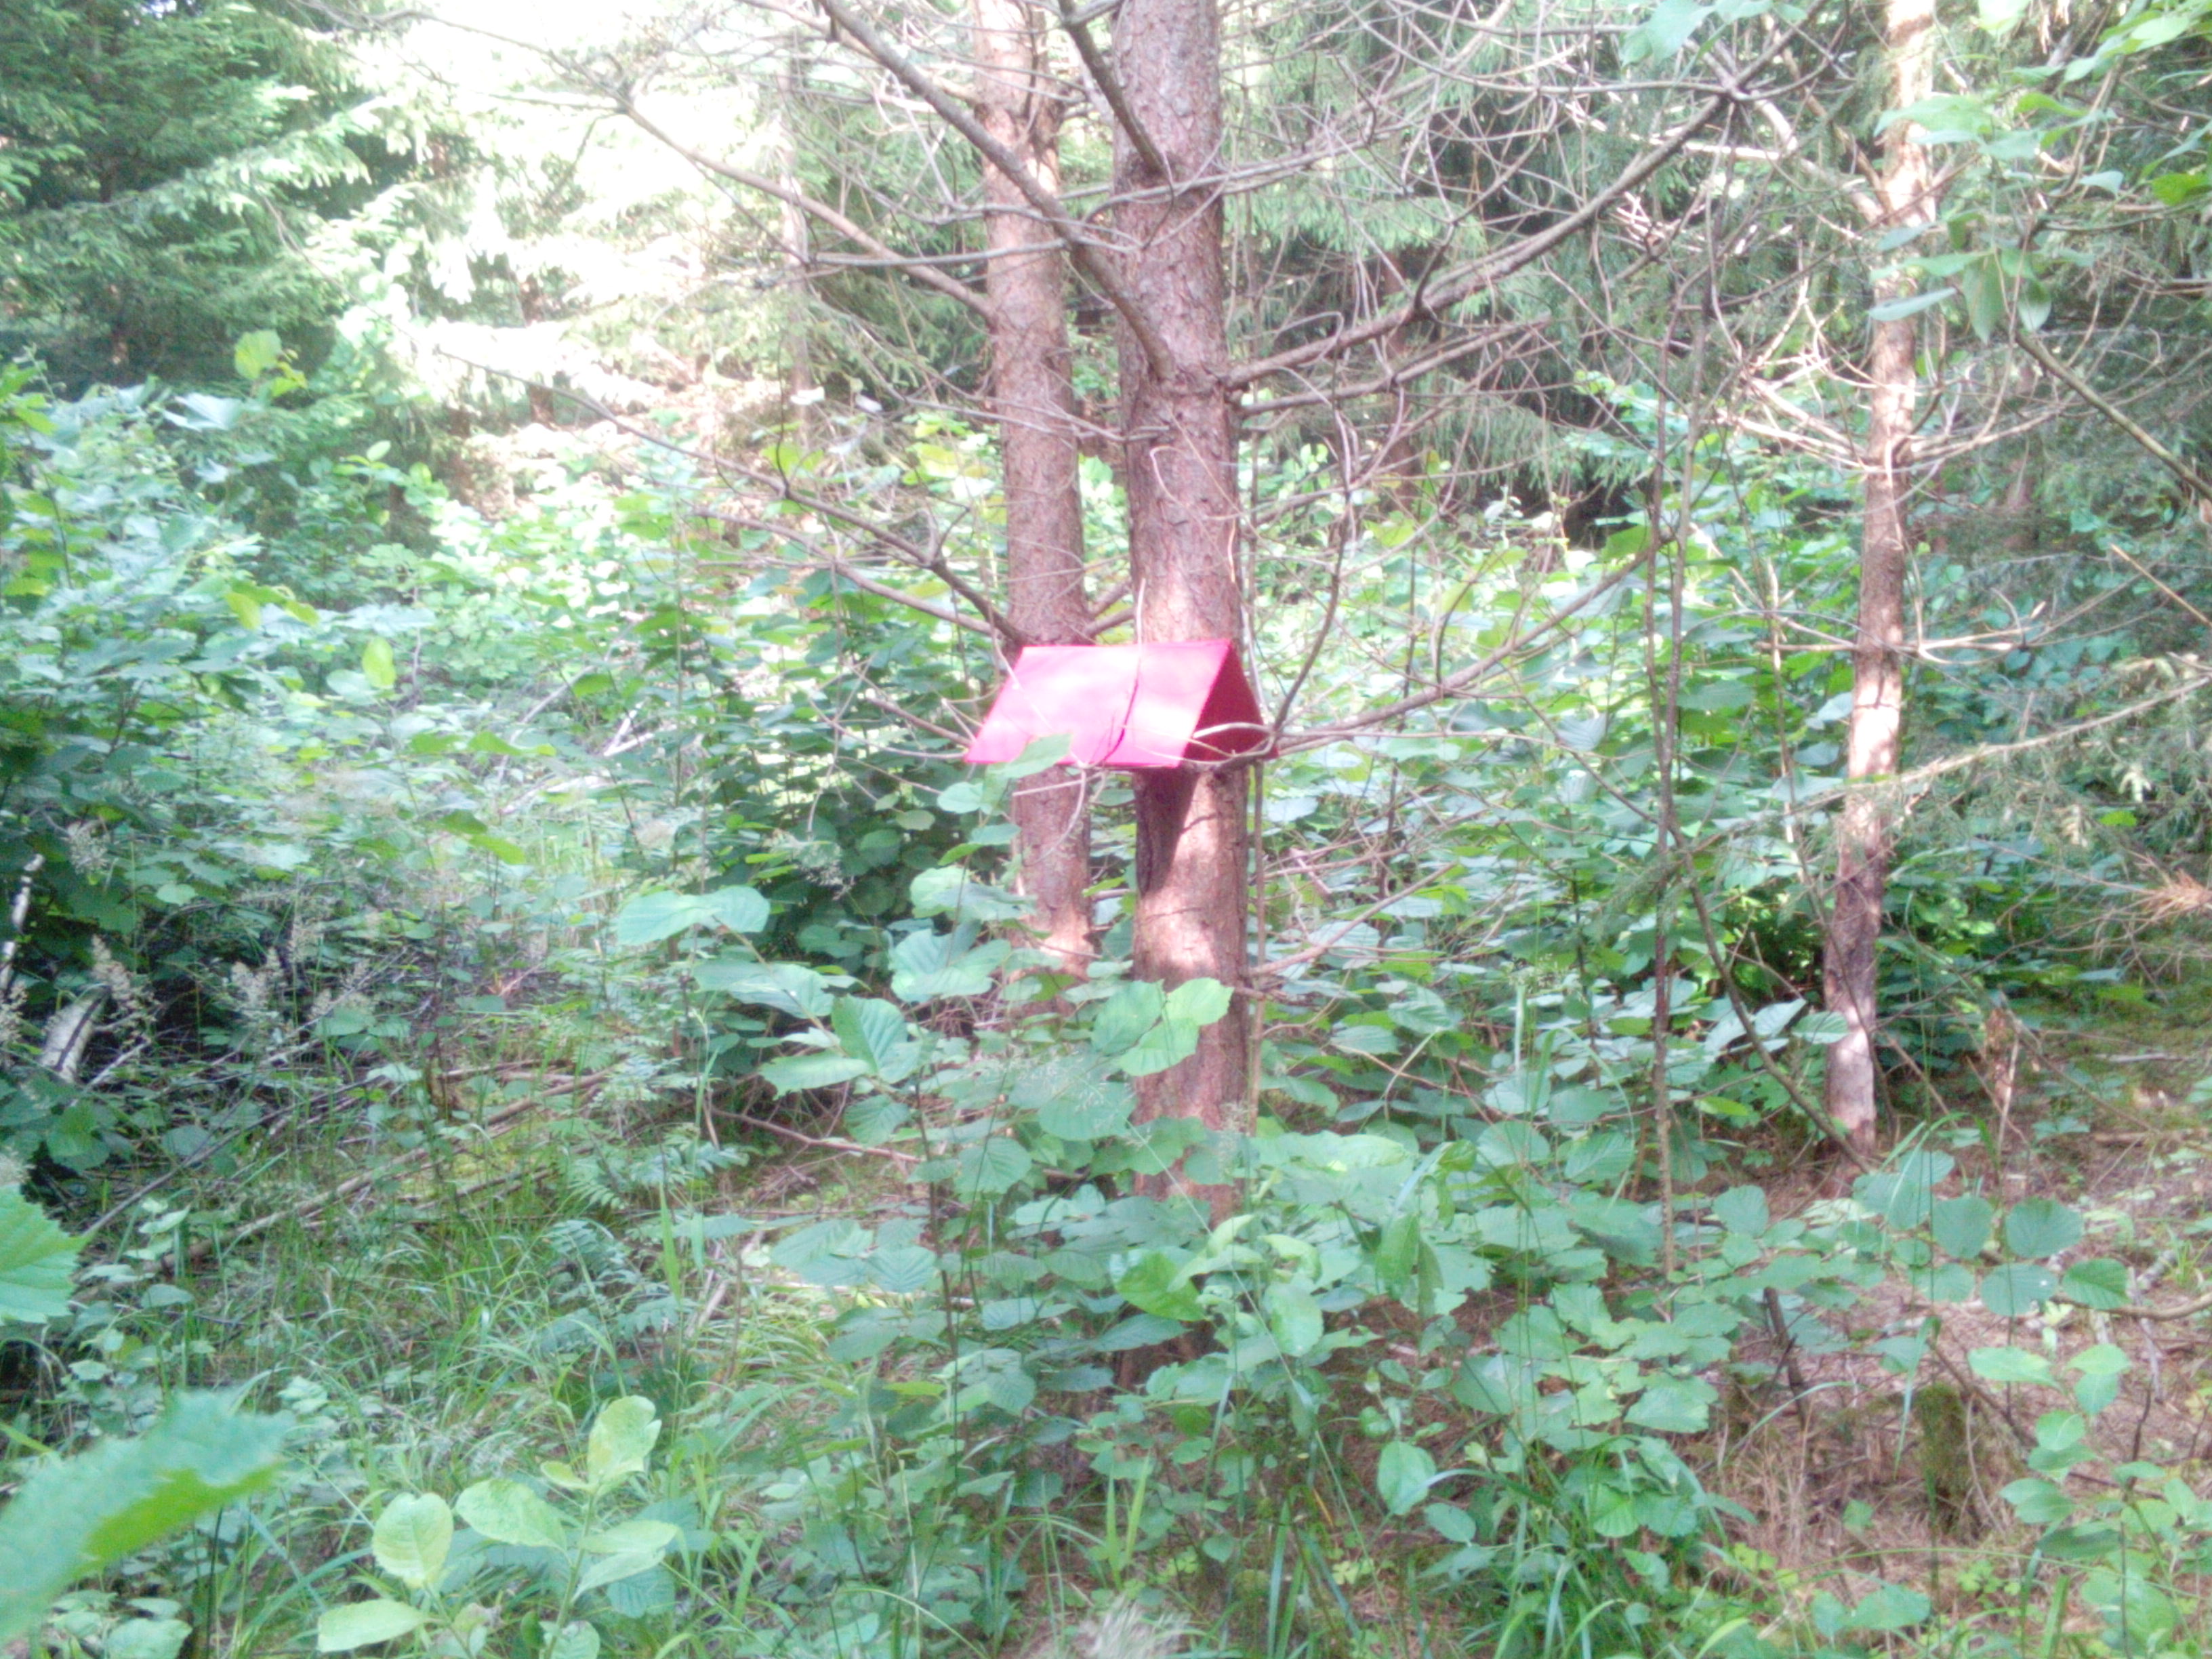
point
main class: Woodland
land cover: Spruce dominated coniferous woodland
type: hemiboreal forest and nemoral coniferous forest and mixed broadleaved-coniferous forest
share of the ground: 50 - 75 %
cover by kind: coniferous forest trees 65 %, herbaceous plants 20 %, broadleaved forest trees 15 %
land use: Forestry
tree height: > 5 m
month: July
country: LV
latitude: 56.6140
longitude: 21.2984
